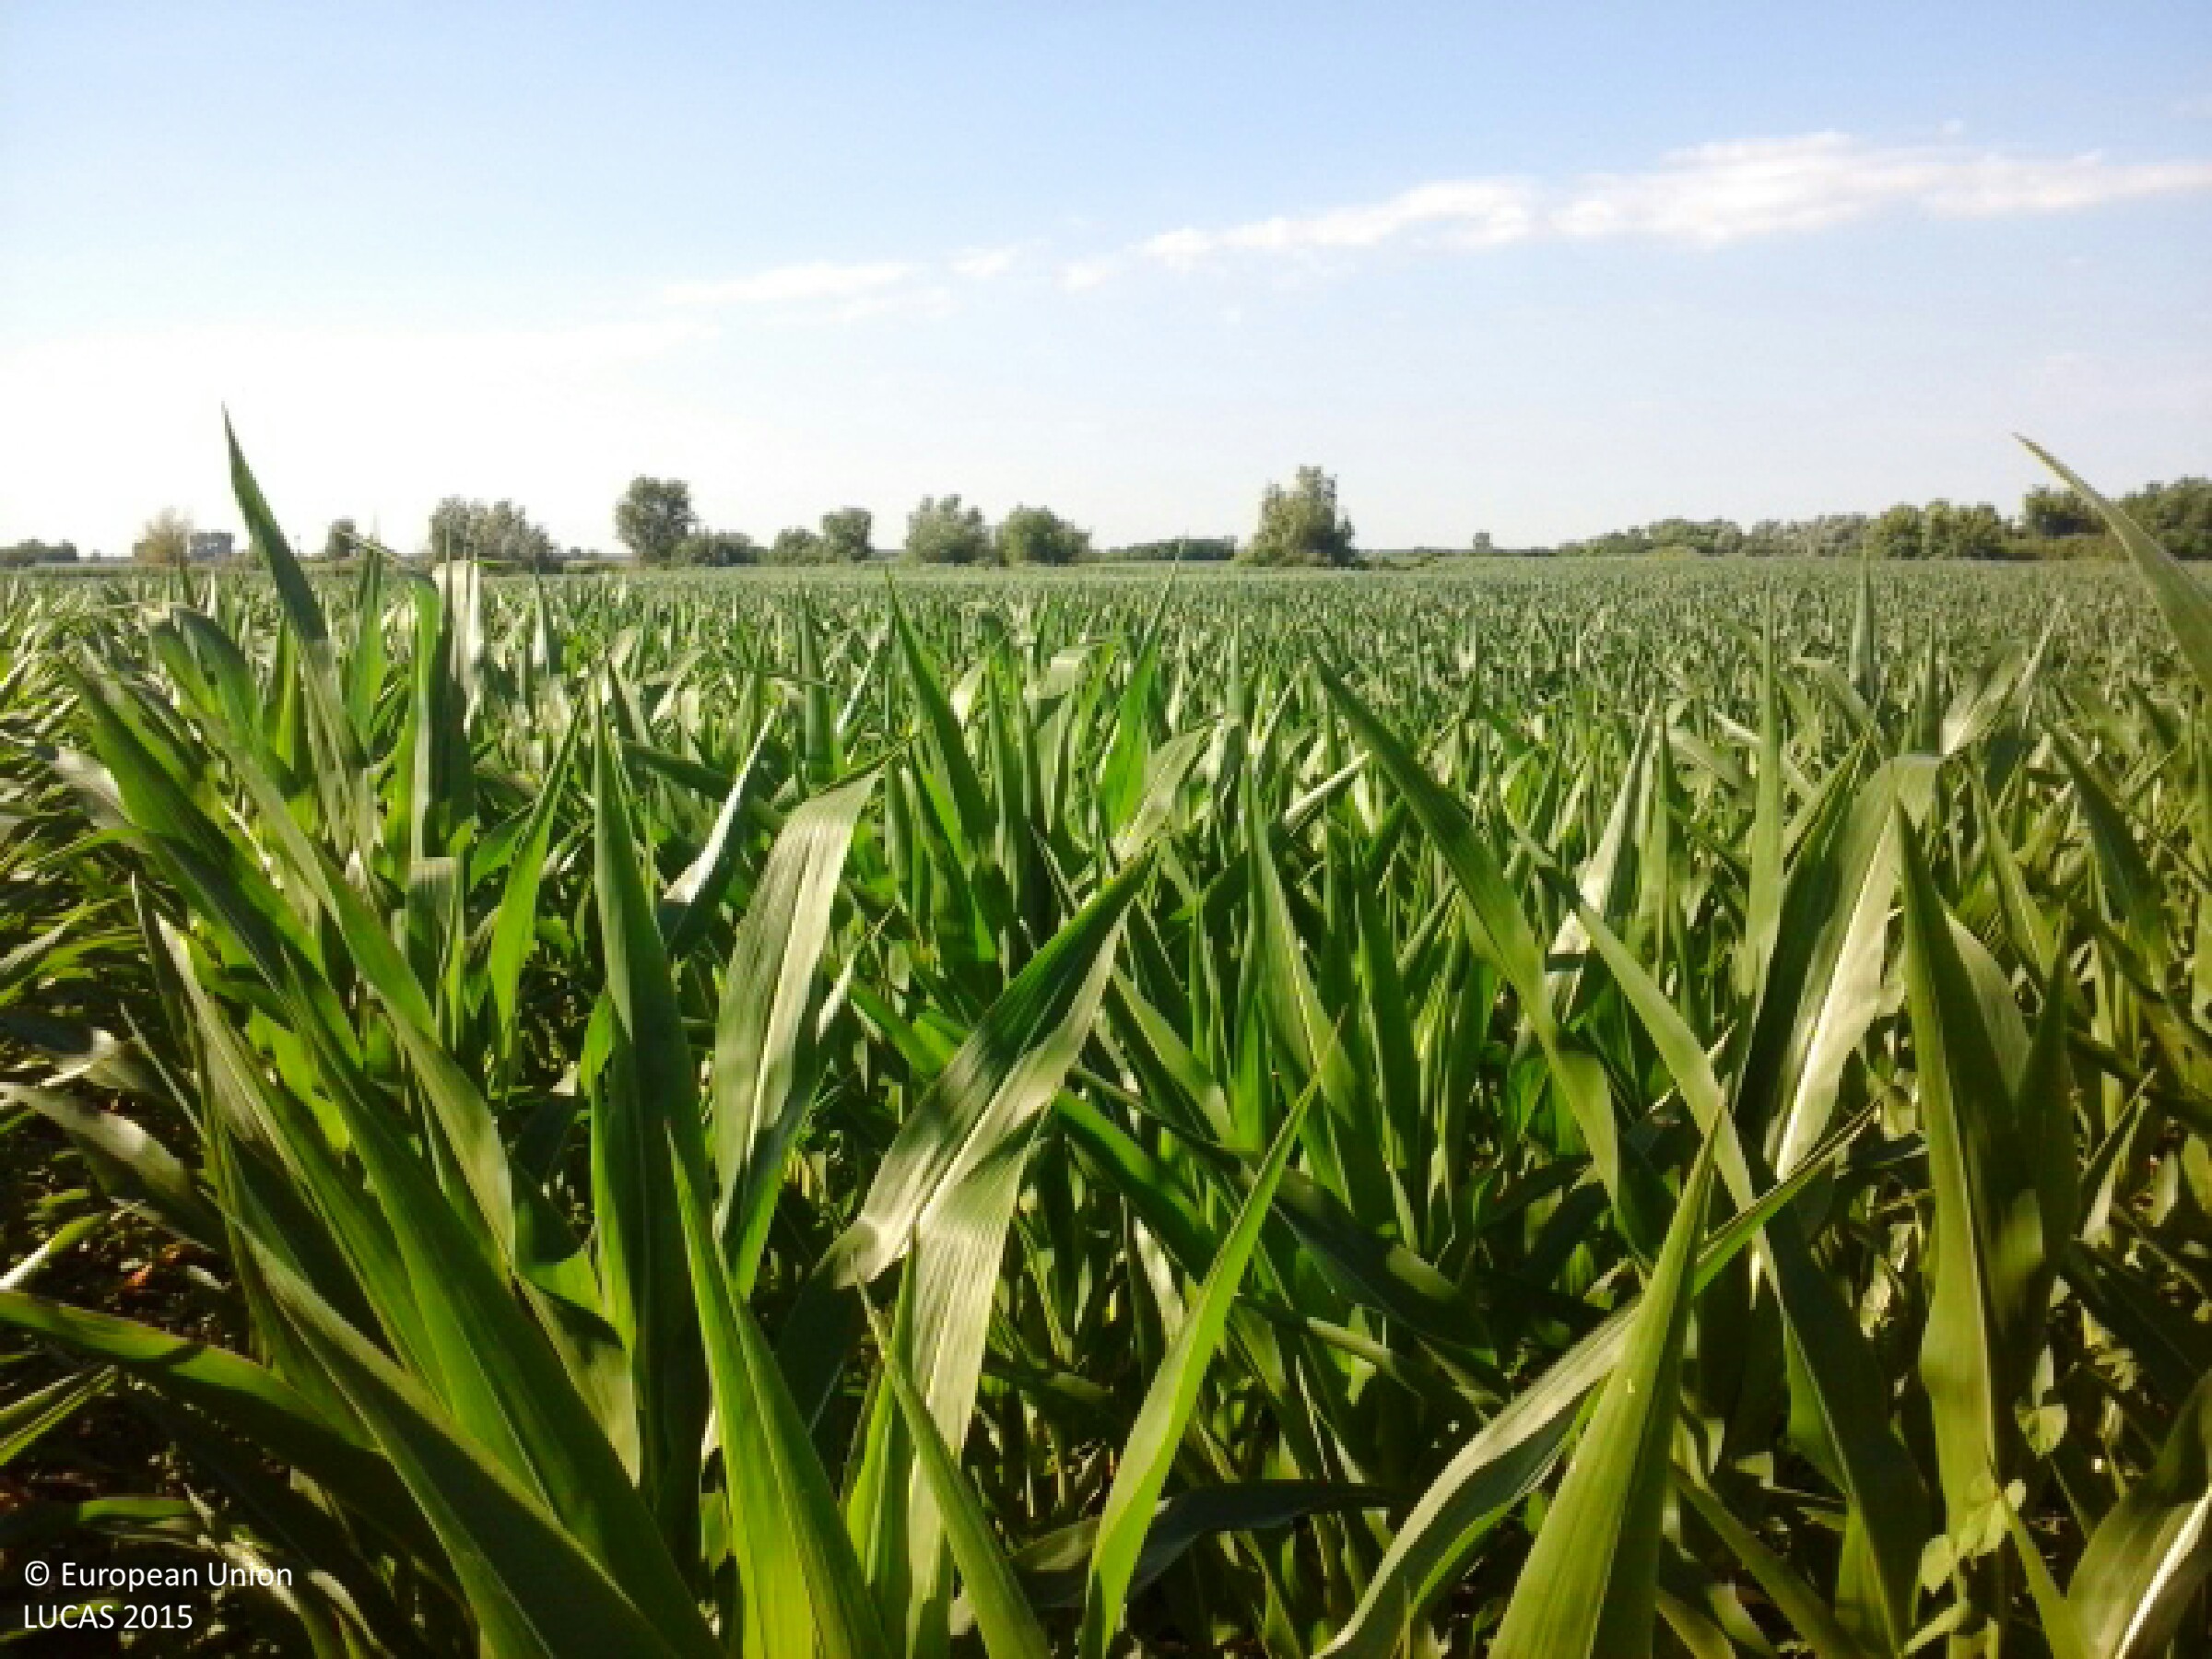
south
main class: Cropland
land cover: Maize
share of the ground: > 75 %
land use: Agriculture (excluding fallow land and kitchen gardens)
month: July
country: HU
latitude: 48.2033
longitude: 21.9877
